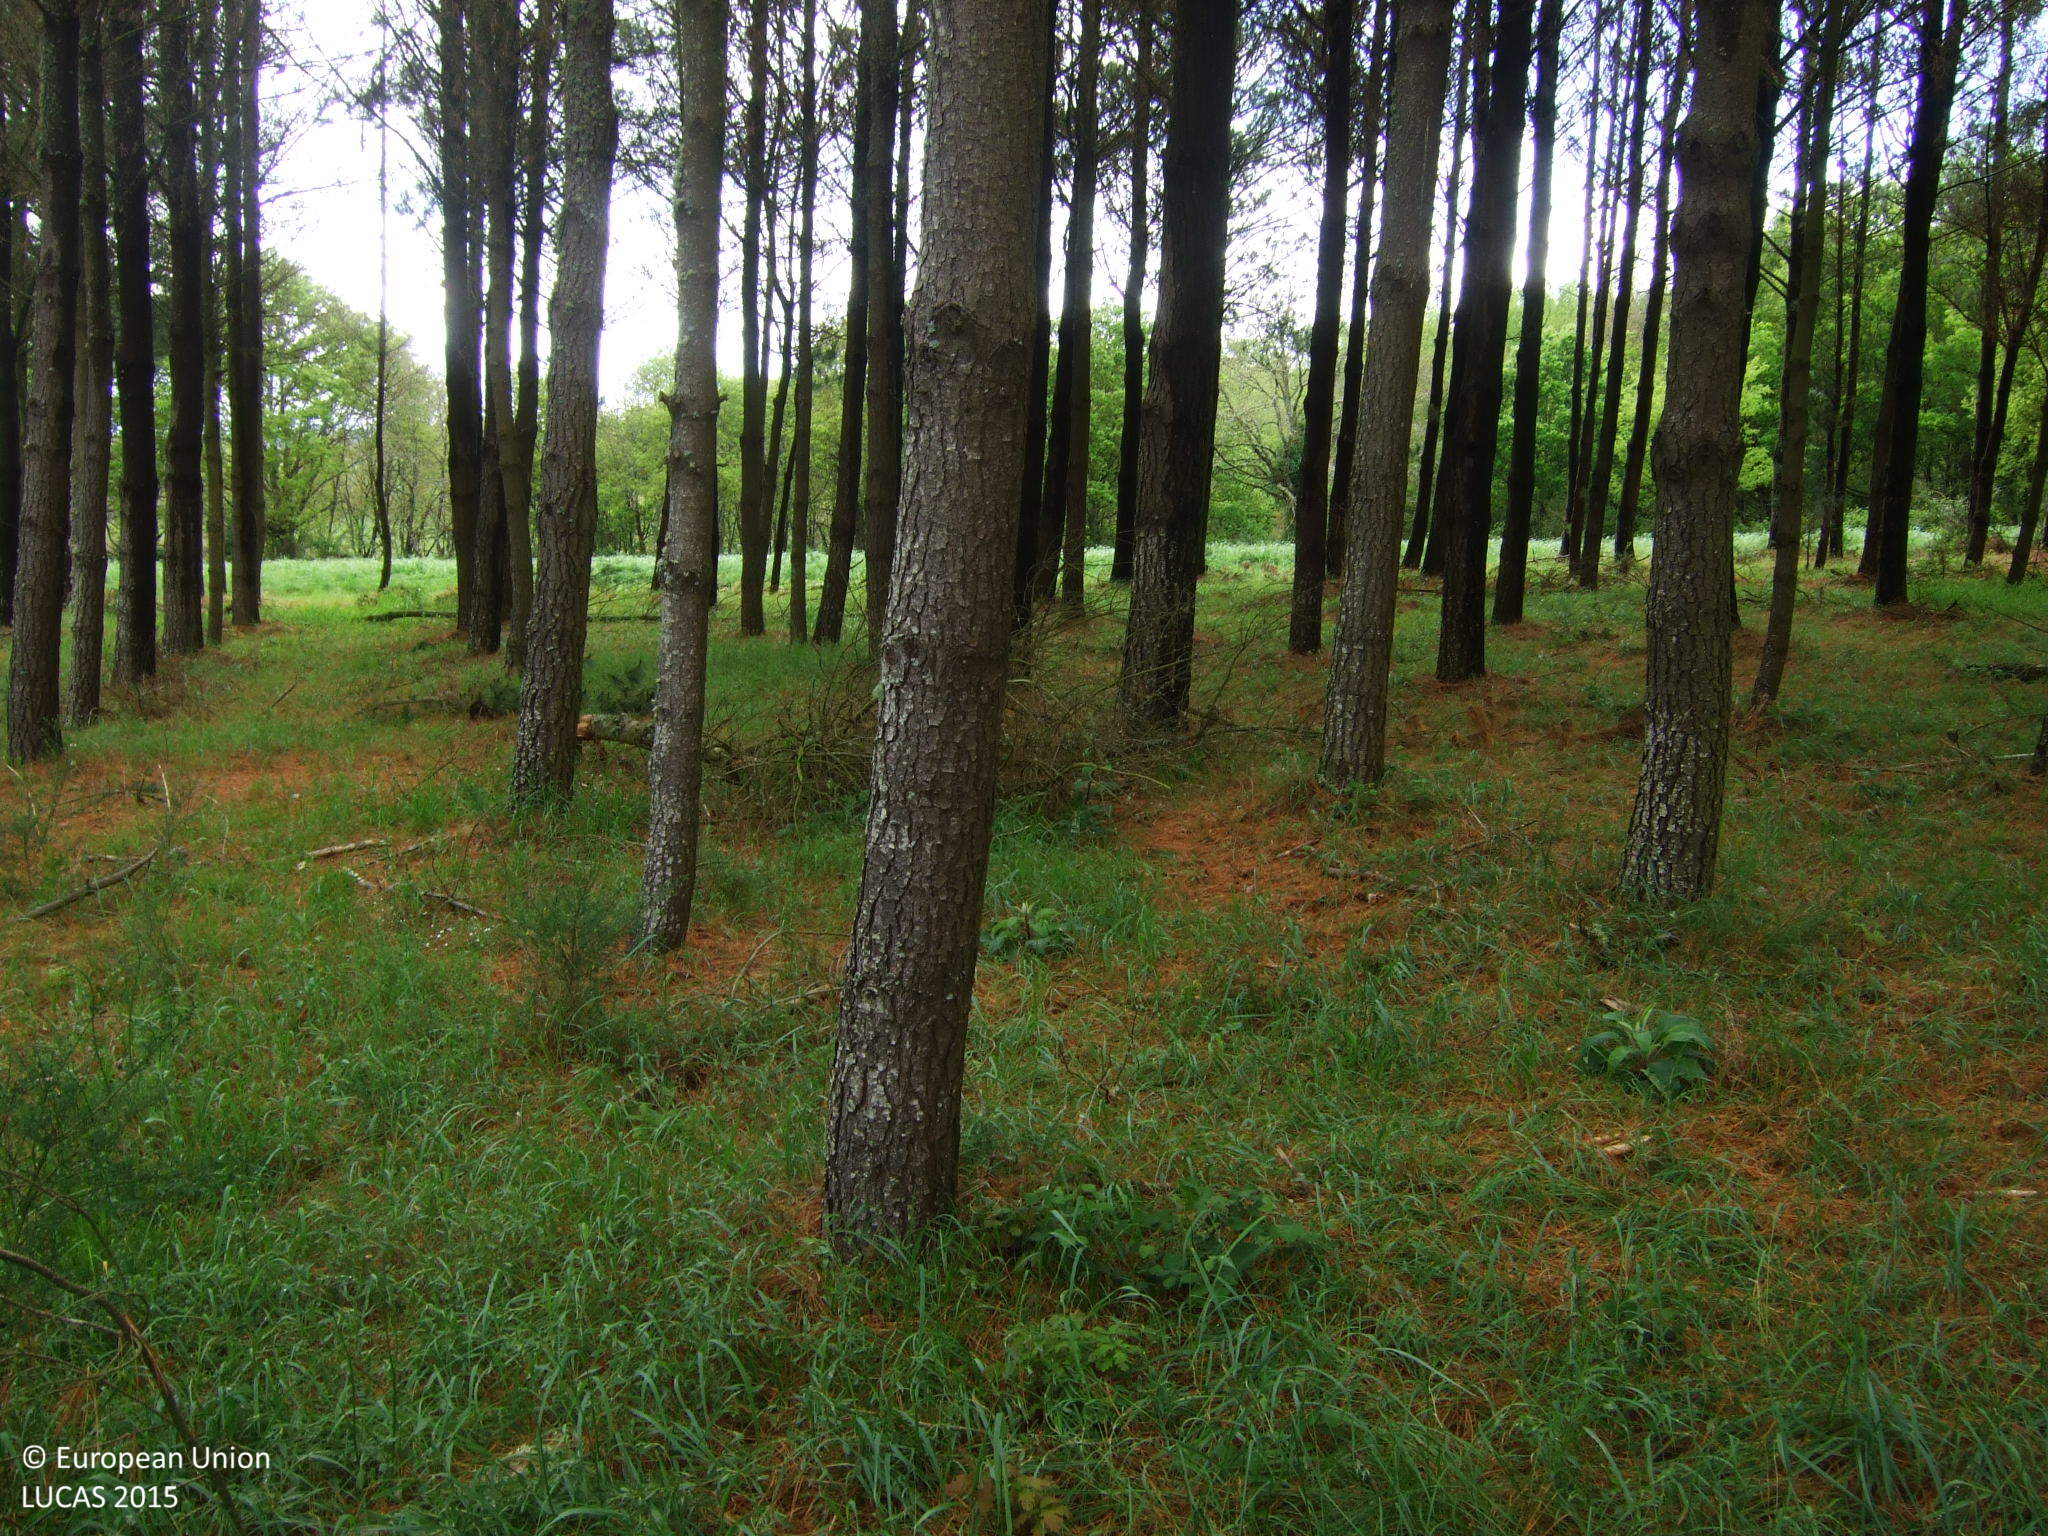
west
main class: Woodland
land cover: Pine dominated coniferous woodland
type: exotic forest
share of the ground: 50 - 75 %
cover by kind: coniferous forest trees 65 %, herbaceous plants 25 %, shrubs 5 %, unconsolidated bare surface 5 %
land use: Forestry
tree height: > 5 m
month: May
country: ES
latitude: 42.7906
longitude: -7.5189
